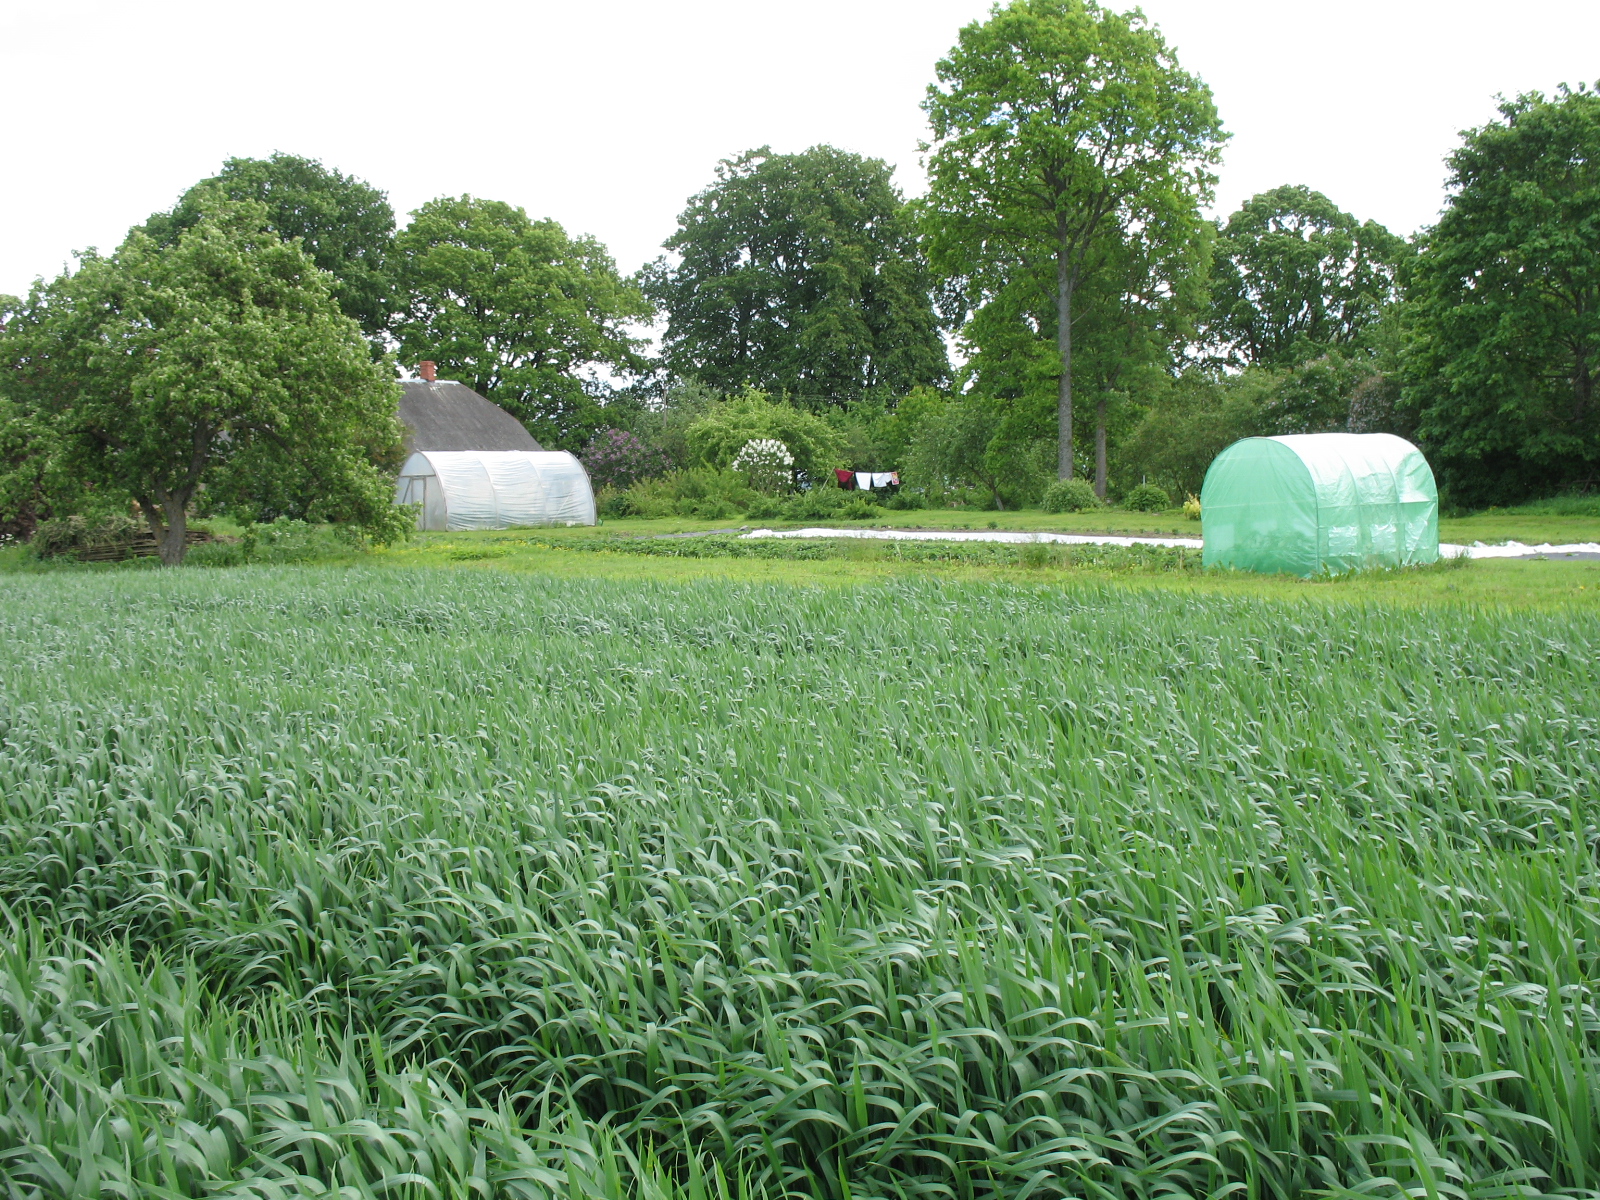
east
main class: Cropland
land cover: Common wheat
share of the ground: > 75 %
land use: Agriculture (excluding fallow land and kitchen gardens)
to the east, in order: Common wheat; Grassland without tree/shrub cover; Strawberries; Grassland without tree/shrub cover; Artificial constructions in urban areas; Apple fruit; Broadleaved woodland; Grass margins; Common wheat; Electric lines; Common wheat; Other fresh vegetables; Other bare soil; Shruby margins; Ditches and canals; Grass margins; Paved roads, cycling and walking lanes
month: June
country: LV
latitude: 56.6956
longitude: 23.4804
